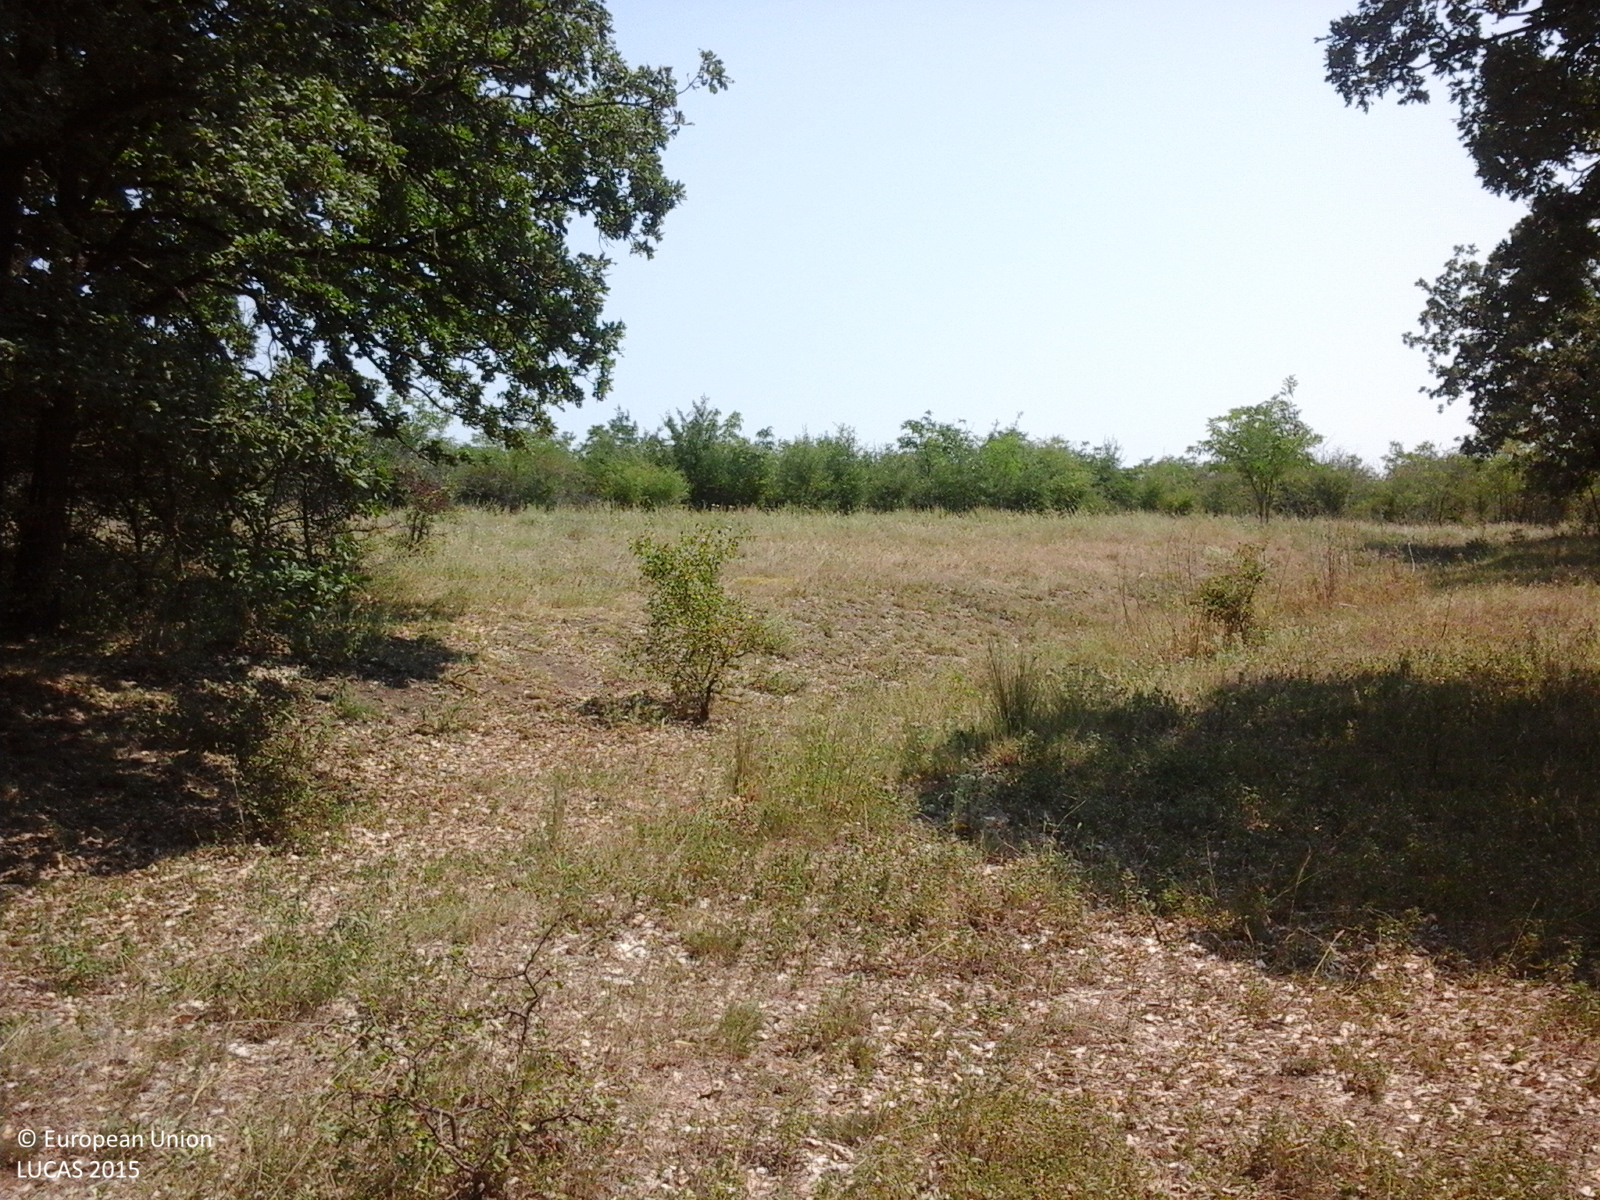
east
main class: Woodland
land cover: Broadleaved woodland
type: acidophilous oak and oak-birch forest
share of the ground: > 75 %
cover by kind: broadleaved forest trees 100 %
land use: Forestry
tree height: > 5 m
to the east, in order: Broadleaved woodland; Tracks; Grassland with sparse tree/shrub cover; Broadleaved woodland; Ditches and canals; Grassland with sparse tree/shrub cover; Grassland without tree/shrub cover
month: July
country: RO
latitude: 45.5738
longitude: 27.9414
